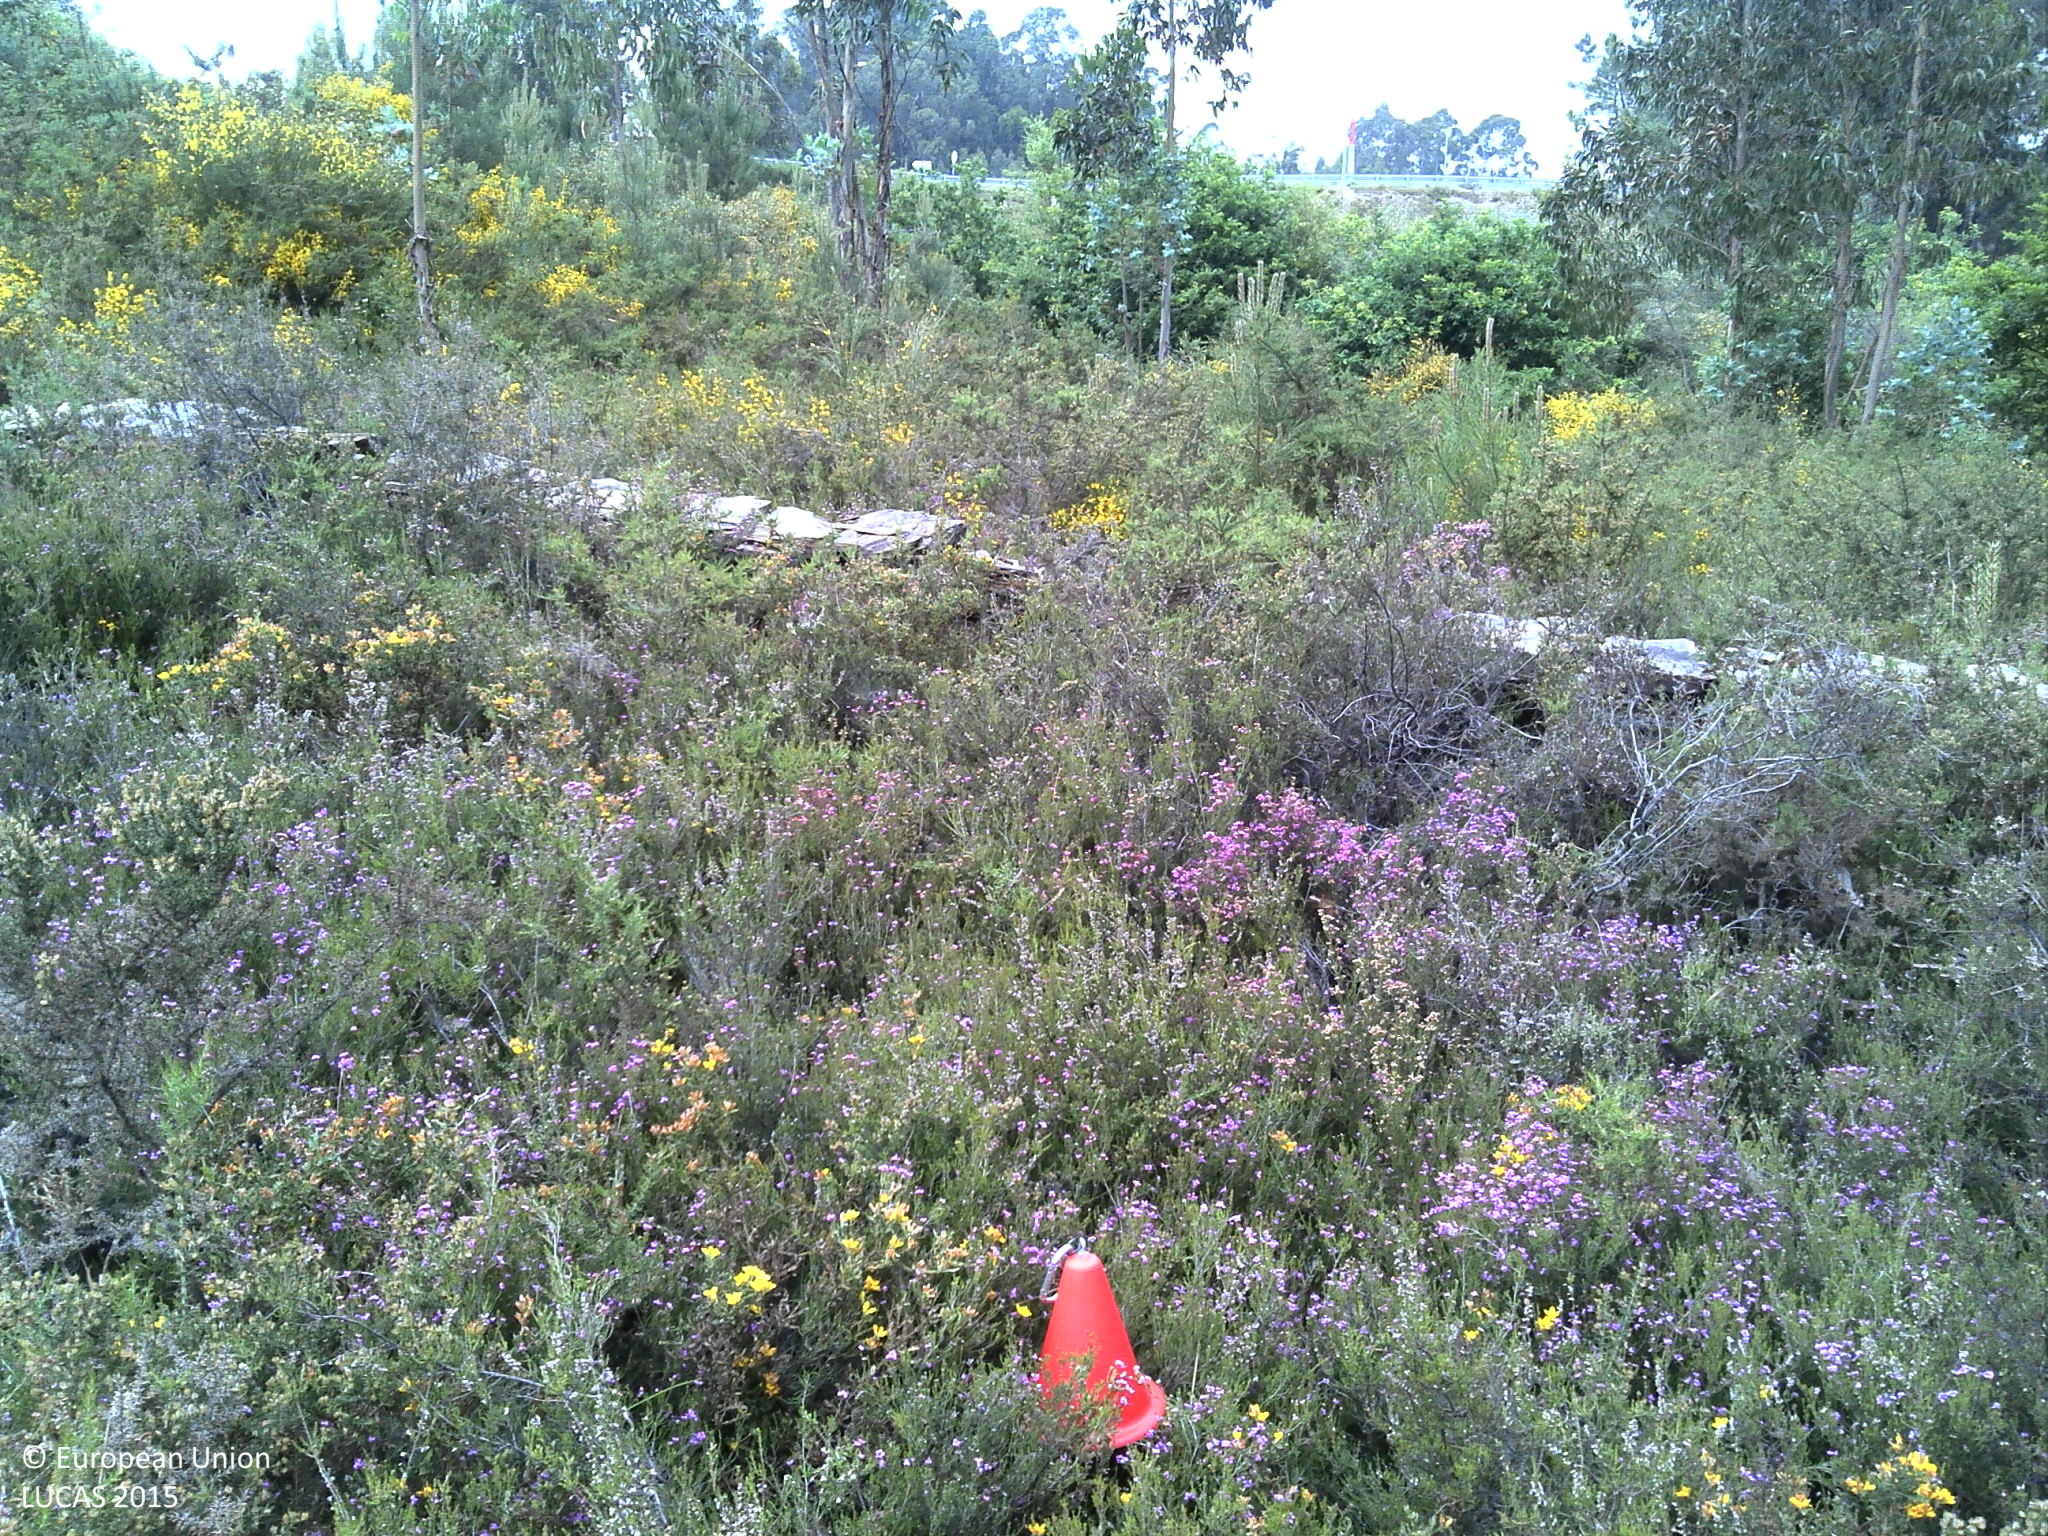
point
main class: Shrubland
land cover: Shrubland with sparse tree cover
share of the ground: > 75 %
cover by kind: shrubs 85 %, unconsolidated bare surface 10 %, broadleaved forest trees 5 %
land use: Forestry
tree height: > 5 m
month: May
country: PT
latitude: 41.1648
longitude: -8.4423
